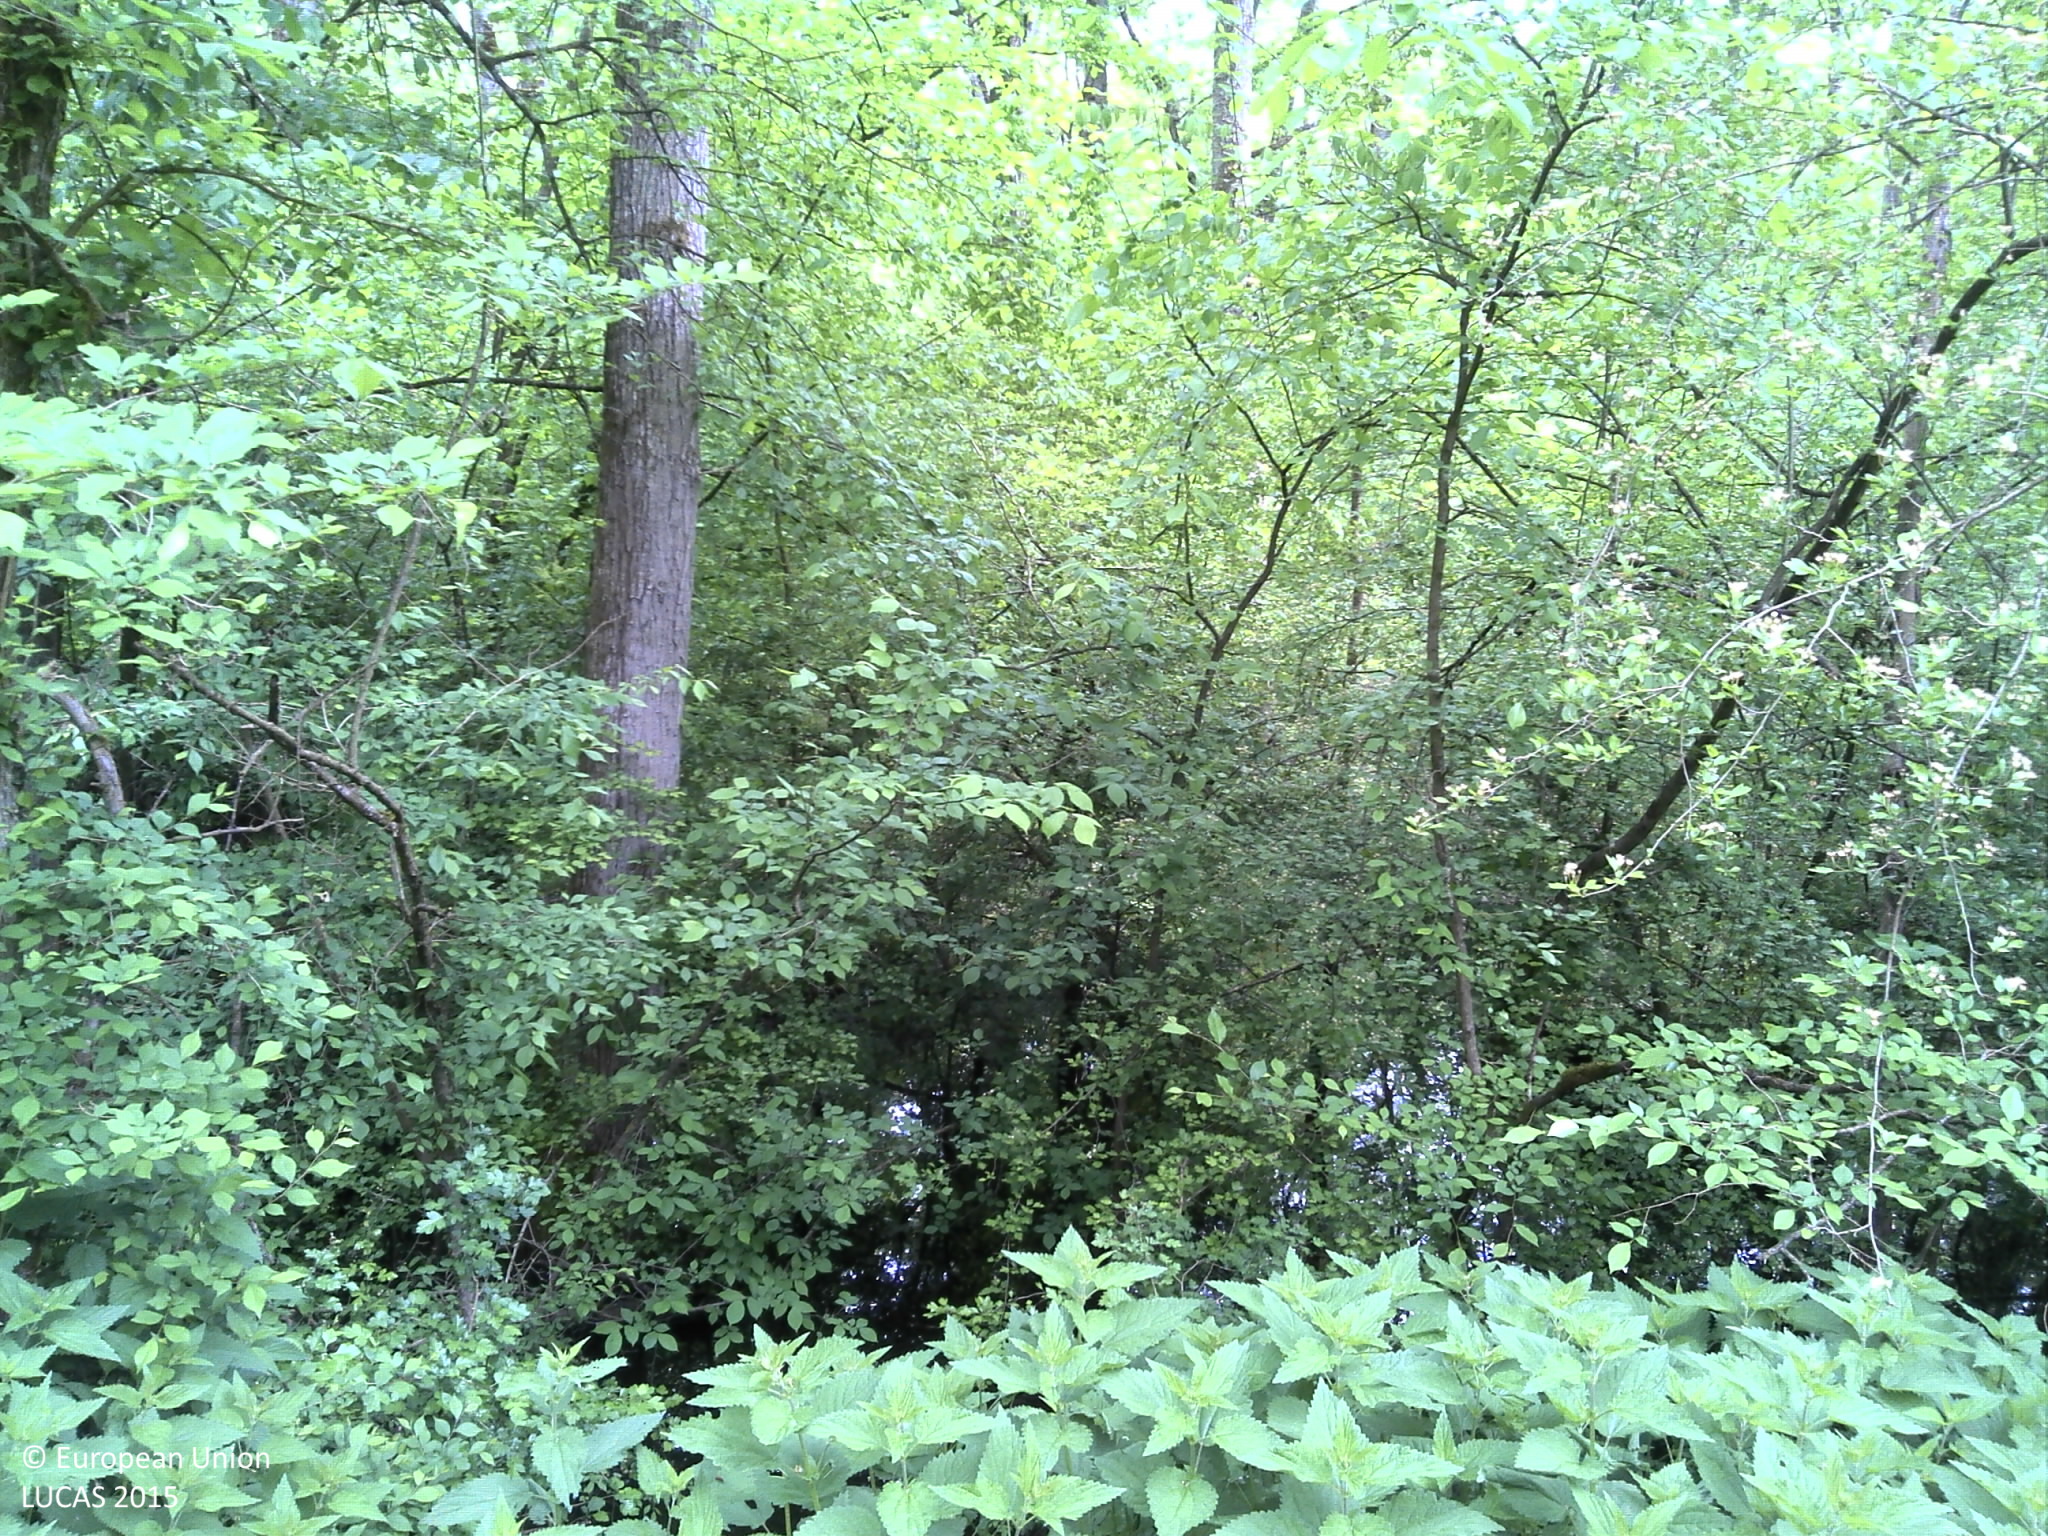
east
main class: Woodland
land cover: Broadleaved woodland
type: mesophytic deciduous forest
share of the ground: > 75 %
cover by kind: broadleaved forest trees 100 %
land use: Forestry
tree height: > 5 m
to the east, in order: Broadleaved woodland
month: May
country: HR
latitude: 45.0254
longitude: 18.8267
